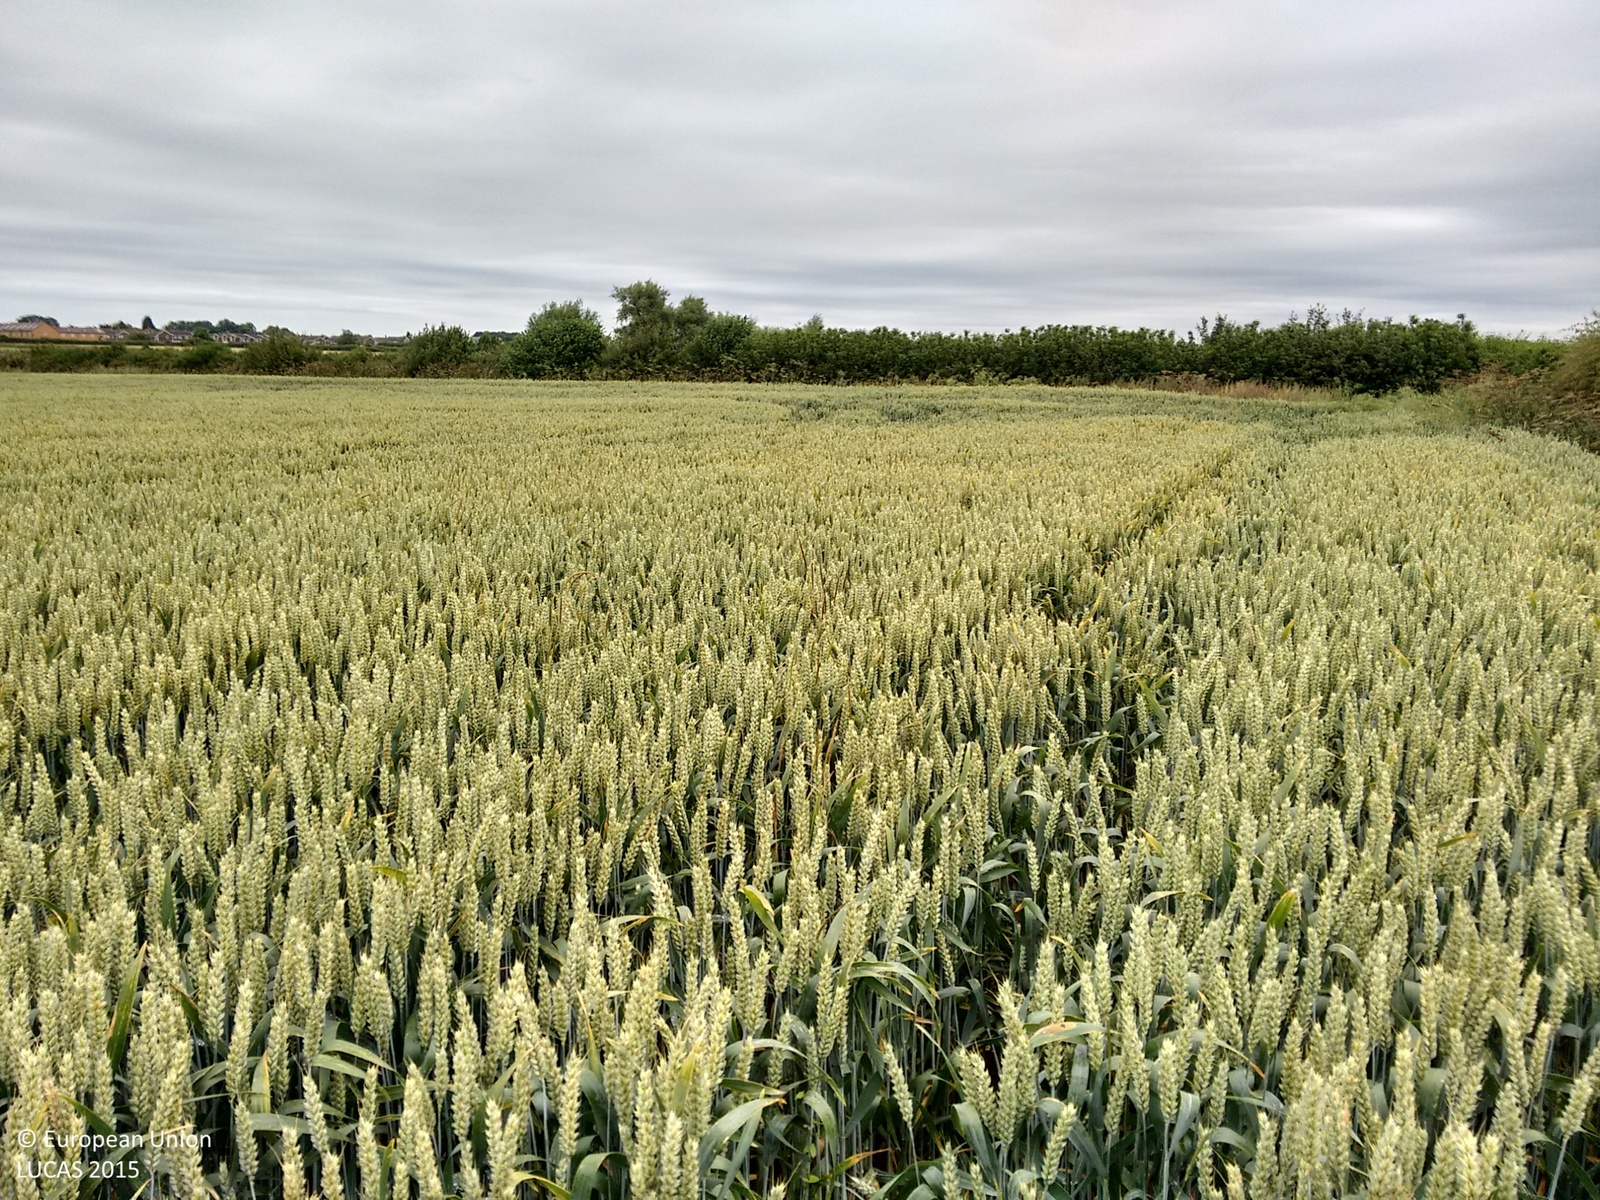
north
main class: Cropland
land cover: Common wheat
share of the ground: > 75 %
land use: Agriculture (excluding fallow land and kitchen gardens)
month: July
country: GB
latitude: 52.5302
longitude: -0.6682
